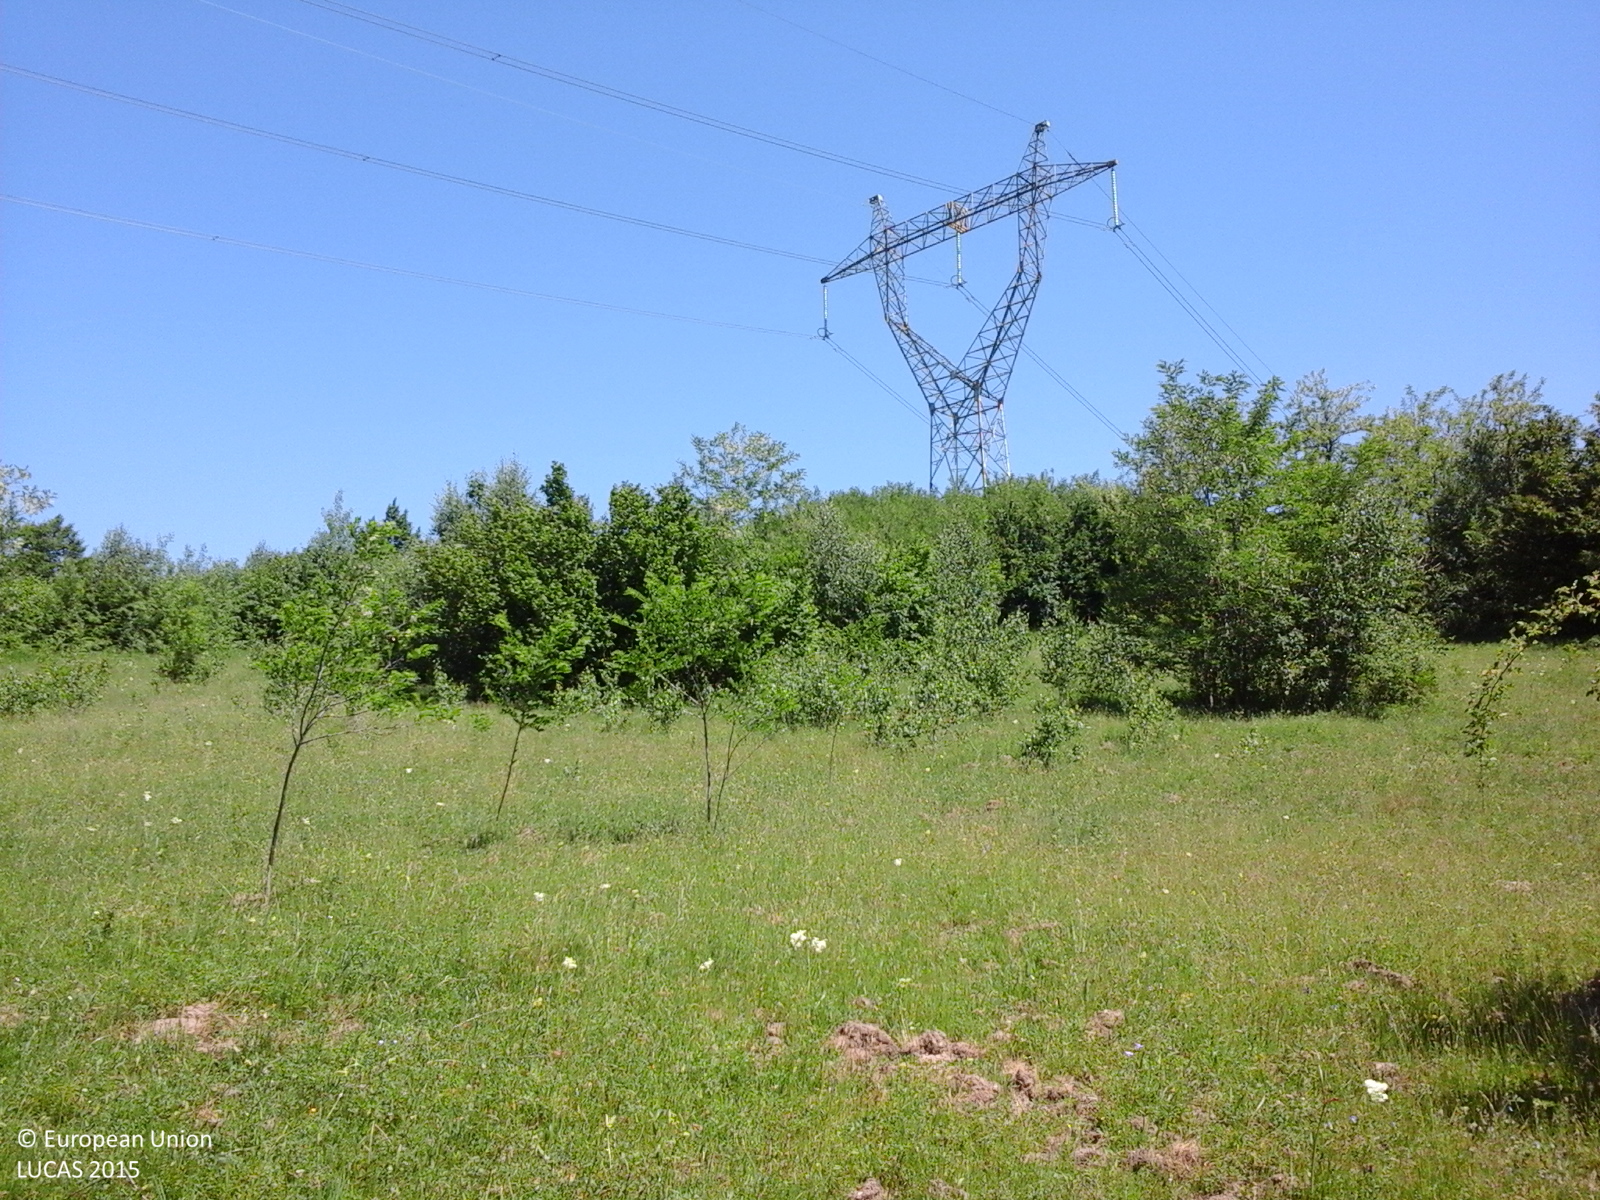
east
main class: Grassland
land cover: Grassland with sparse tree/shrub cover
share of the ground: > 75 %
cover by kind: herbaceous plants 85 %, shrubs 10 %, broadleaved forest trees 5 %
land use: Agriculture (excluding fallow land and kitchen gardens)
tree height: > 5 m
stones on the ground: < 10 %
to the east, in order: Grassland with sparse tree/shrub cover; Electric lines; Broadleaved woodland
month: June
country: RO
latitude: 45.2113
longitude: 25.7528
